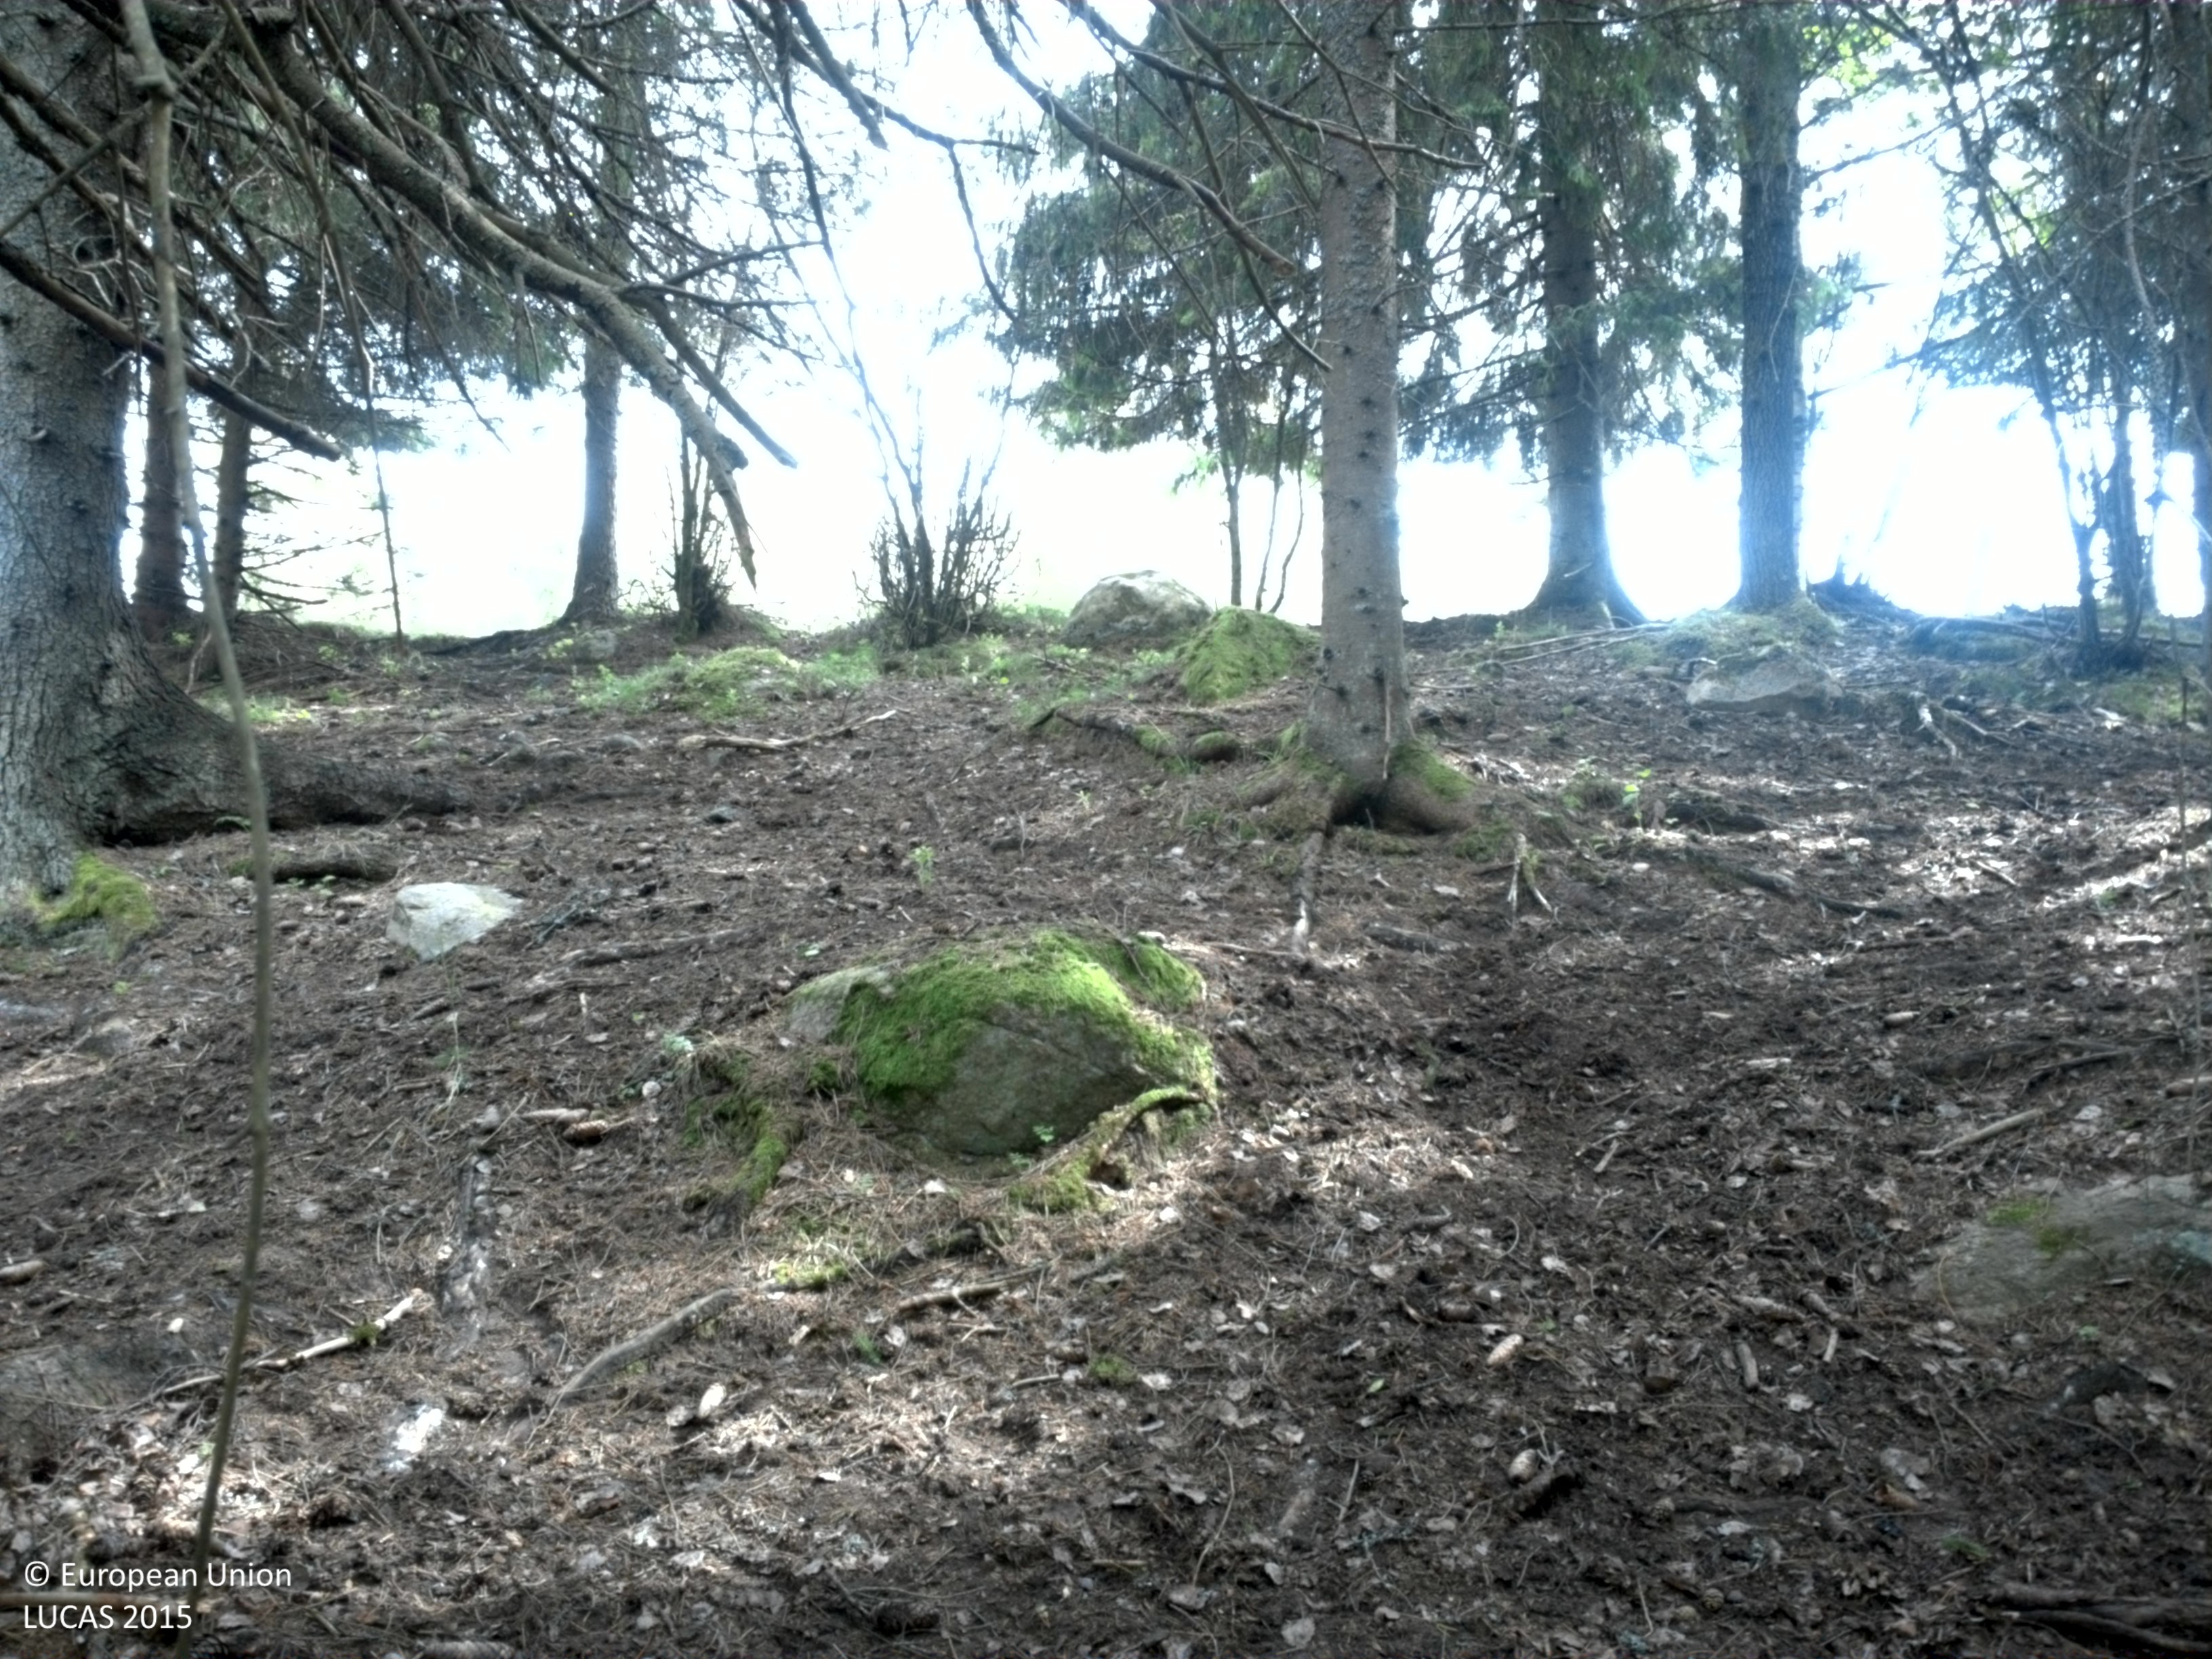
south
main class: Woodland
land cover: Spruce dominated coniferous woodland
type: boreal forest
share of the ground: > 75 %
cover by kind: coniferous forest trees 80 %, broadleaved forest trees 10 %, lichens and mosses 10 %
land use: Forestry
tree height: > 5 m
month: July
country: SE
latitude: 57.5419
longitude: 14.7236
